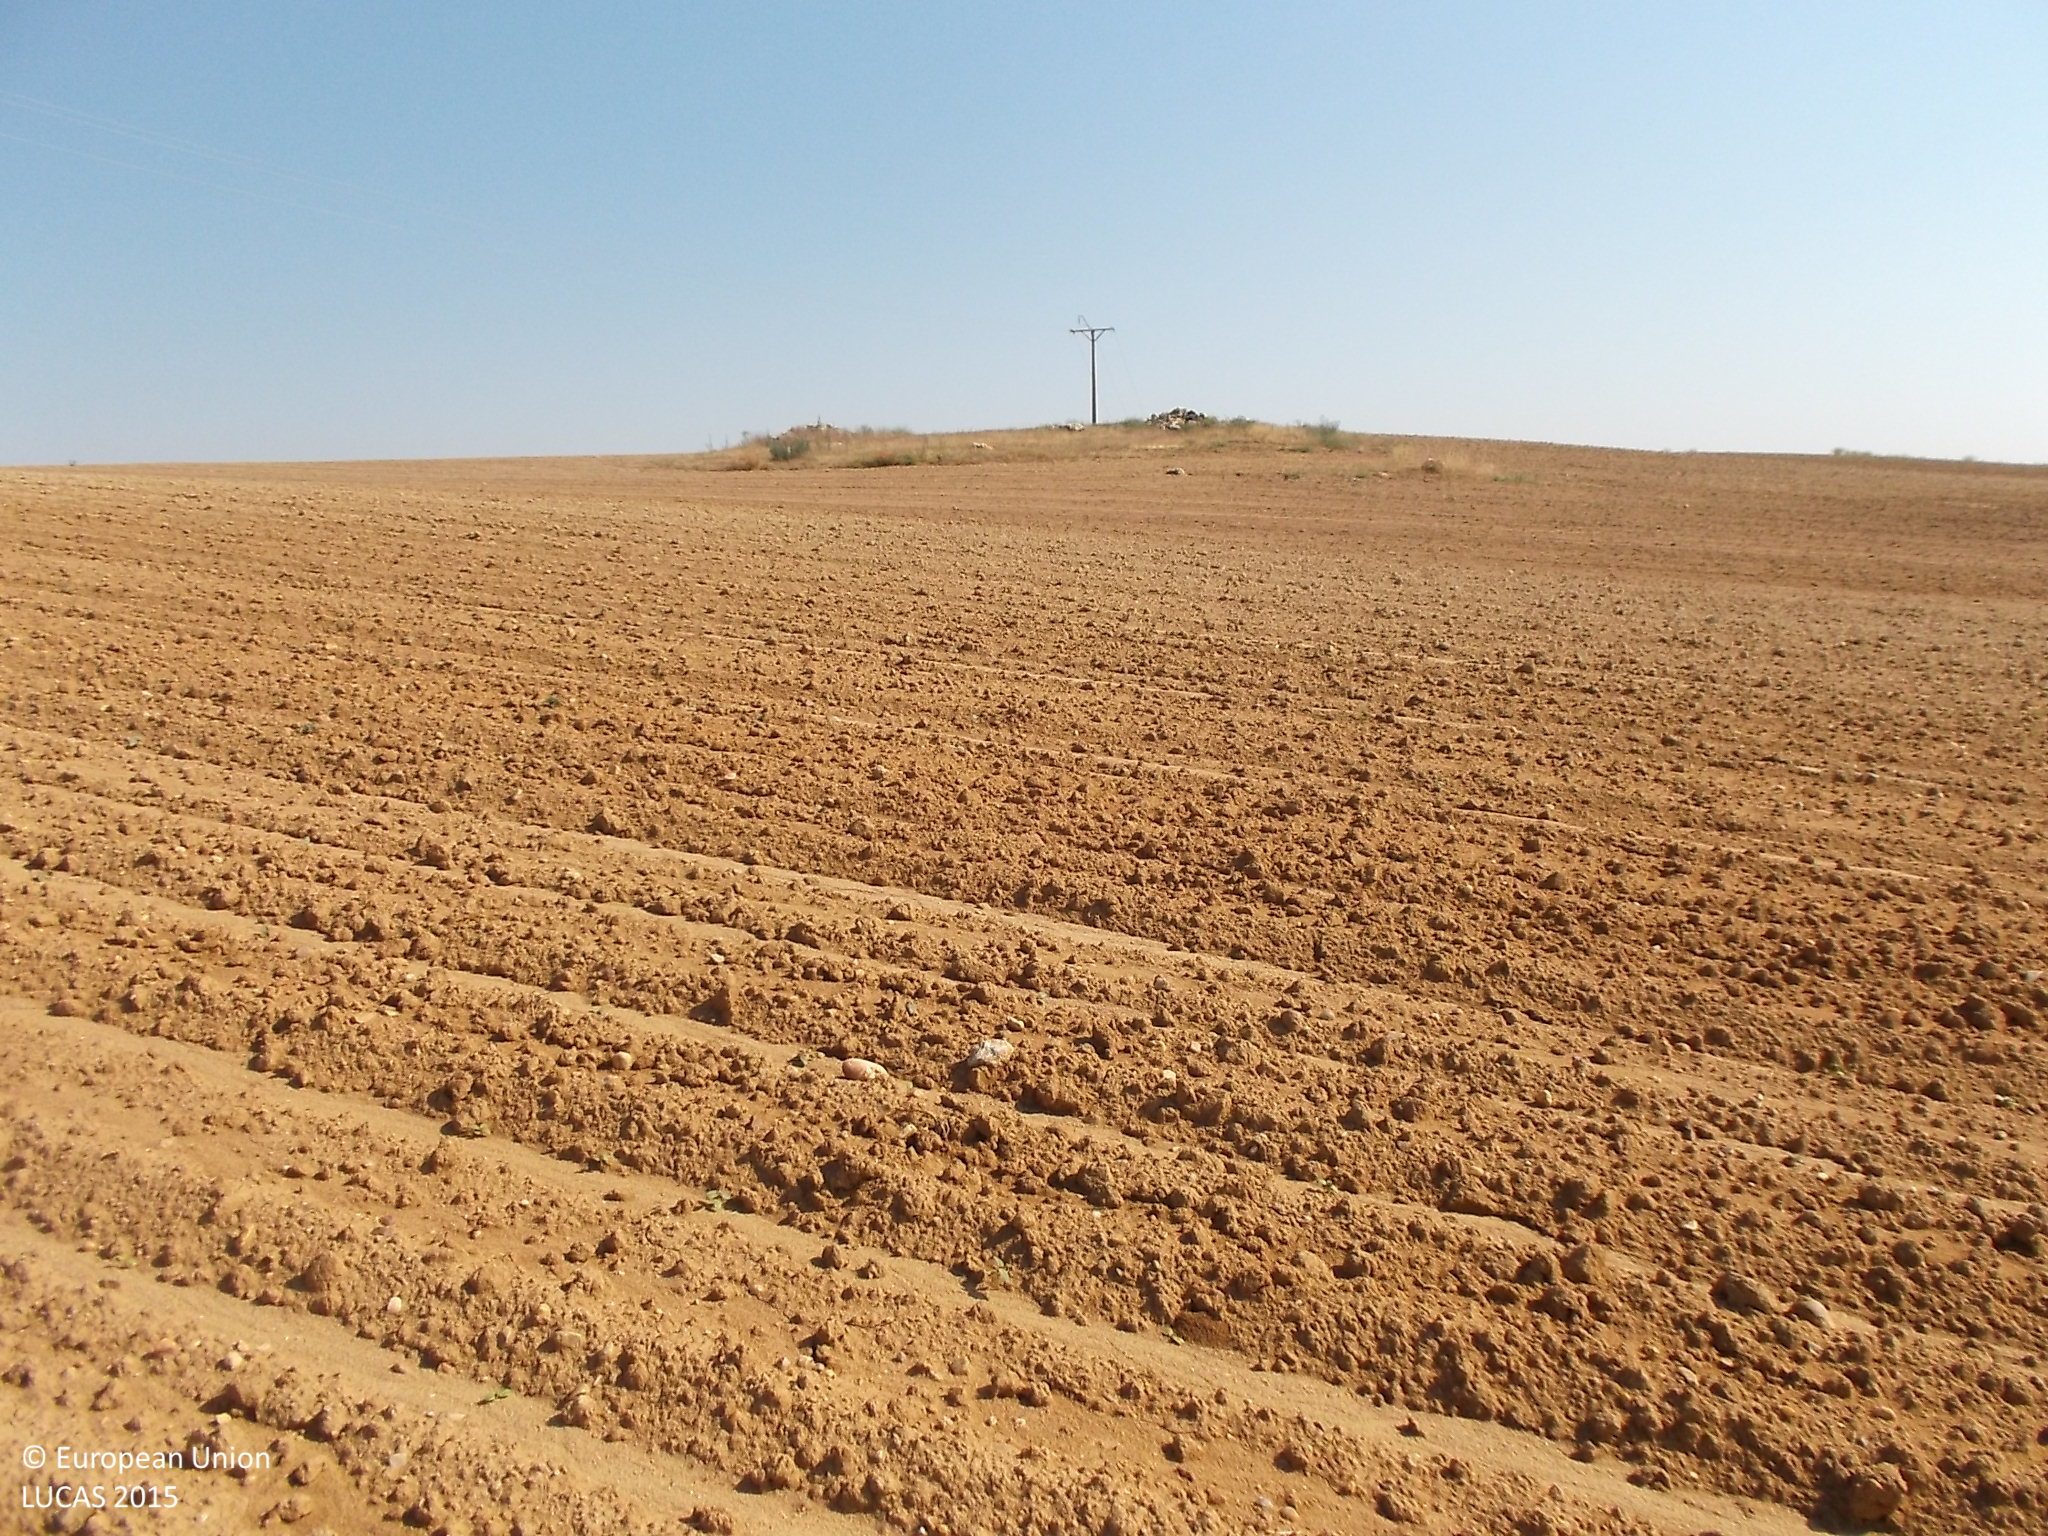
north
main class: Cropland
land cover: Sunflower
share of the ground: < 10 %
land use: Agriculture (excluding fallow land and kitchen gardens)
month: June
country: ES
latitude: 41.3168
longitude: -5.4280
